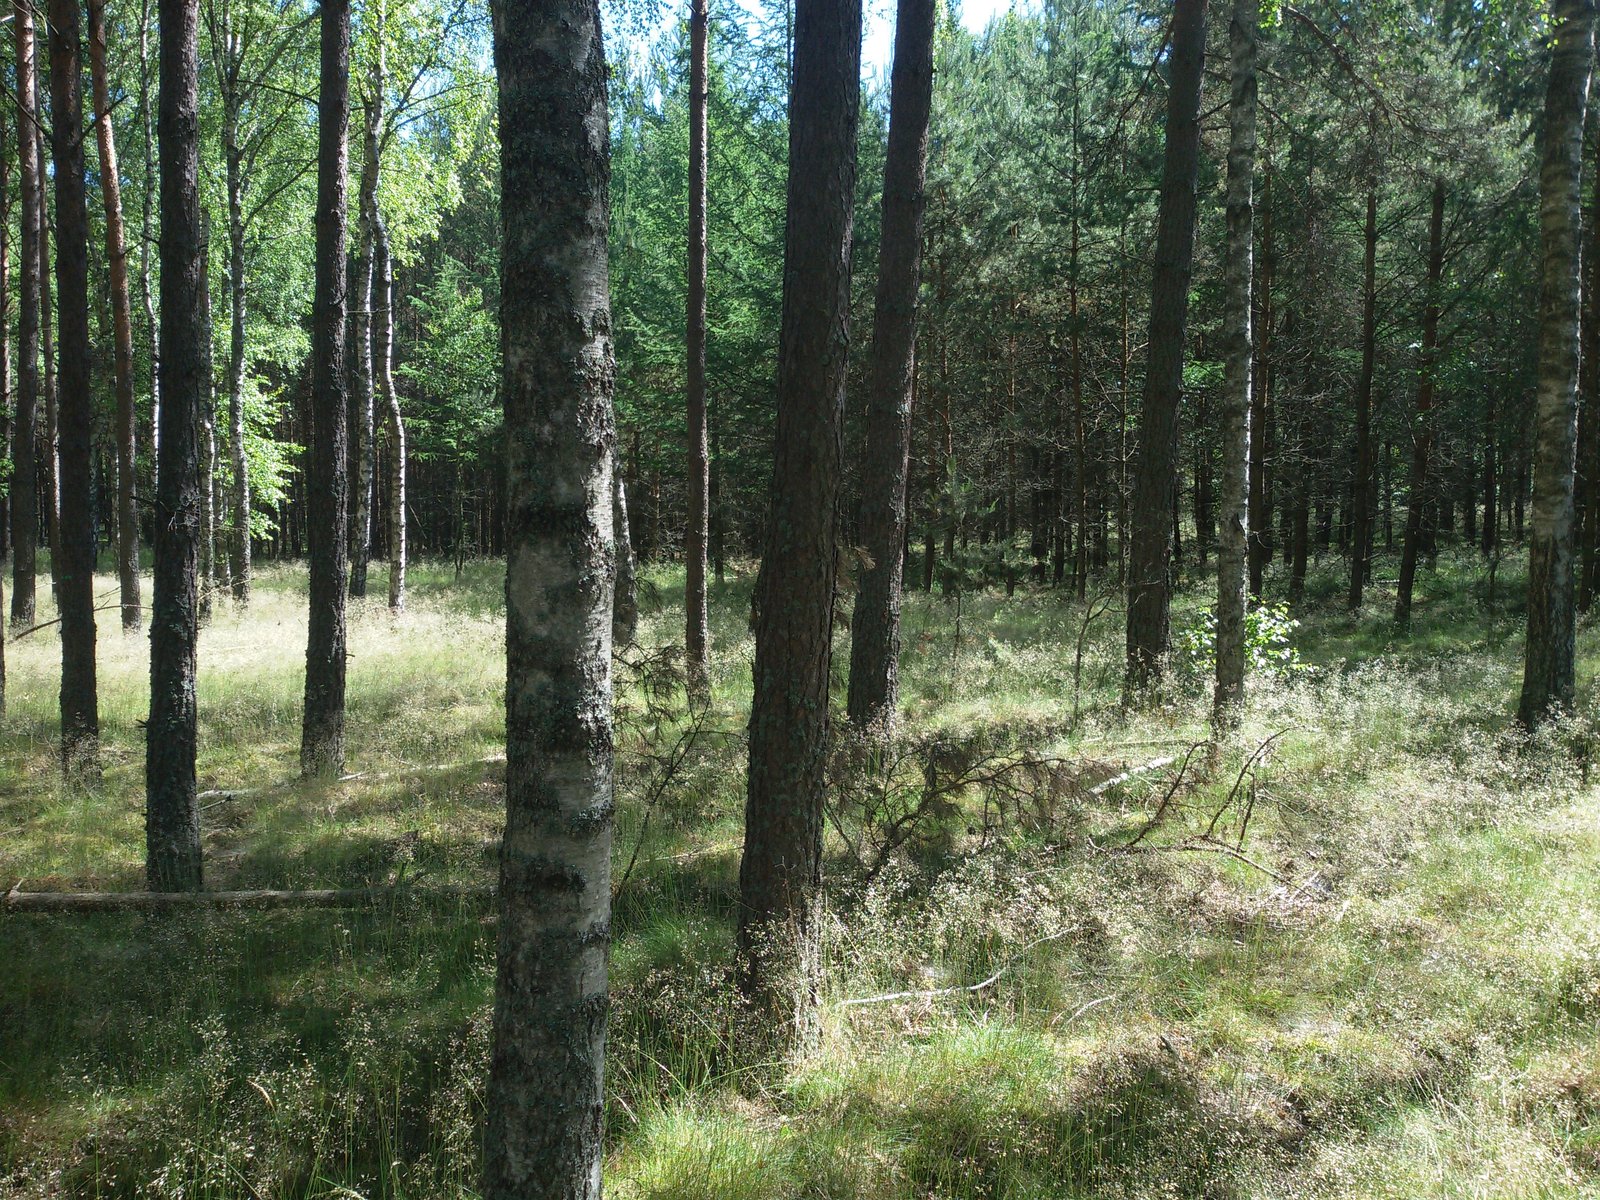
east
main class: Woodland
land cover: Pine dominated mixed woodland
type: hemiboreal forest and nemoral coniferous forest and mixed broadleaved-coniferous forest
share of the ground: > 75 %
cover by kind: coniferous forest trees 60 %, broadleaved forest trees 30 %, herbaceous plants 10 %
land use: Forestry
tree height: > 5 m
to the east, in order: Pine dominated mixed woodland; Grass margins; Pine dominated coniferous woodland; Tracks; Pine dominated coniferous woodland; Tracks; Pine dominated coniferous woodland
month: July
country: PL
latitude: 53.4714
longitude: 16.3185
